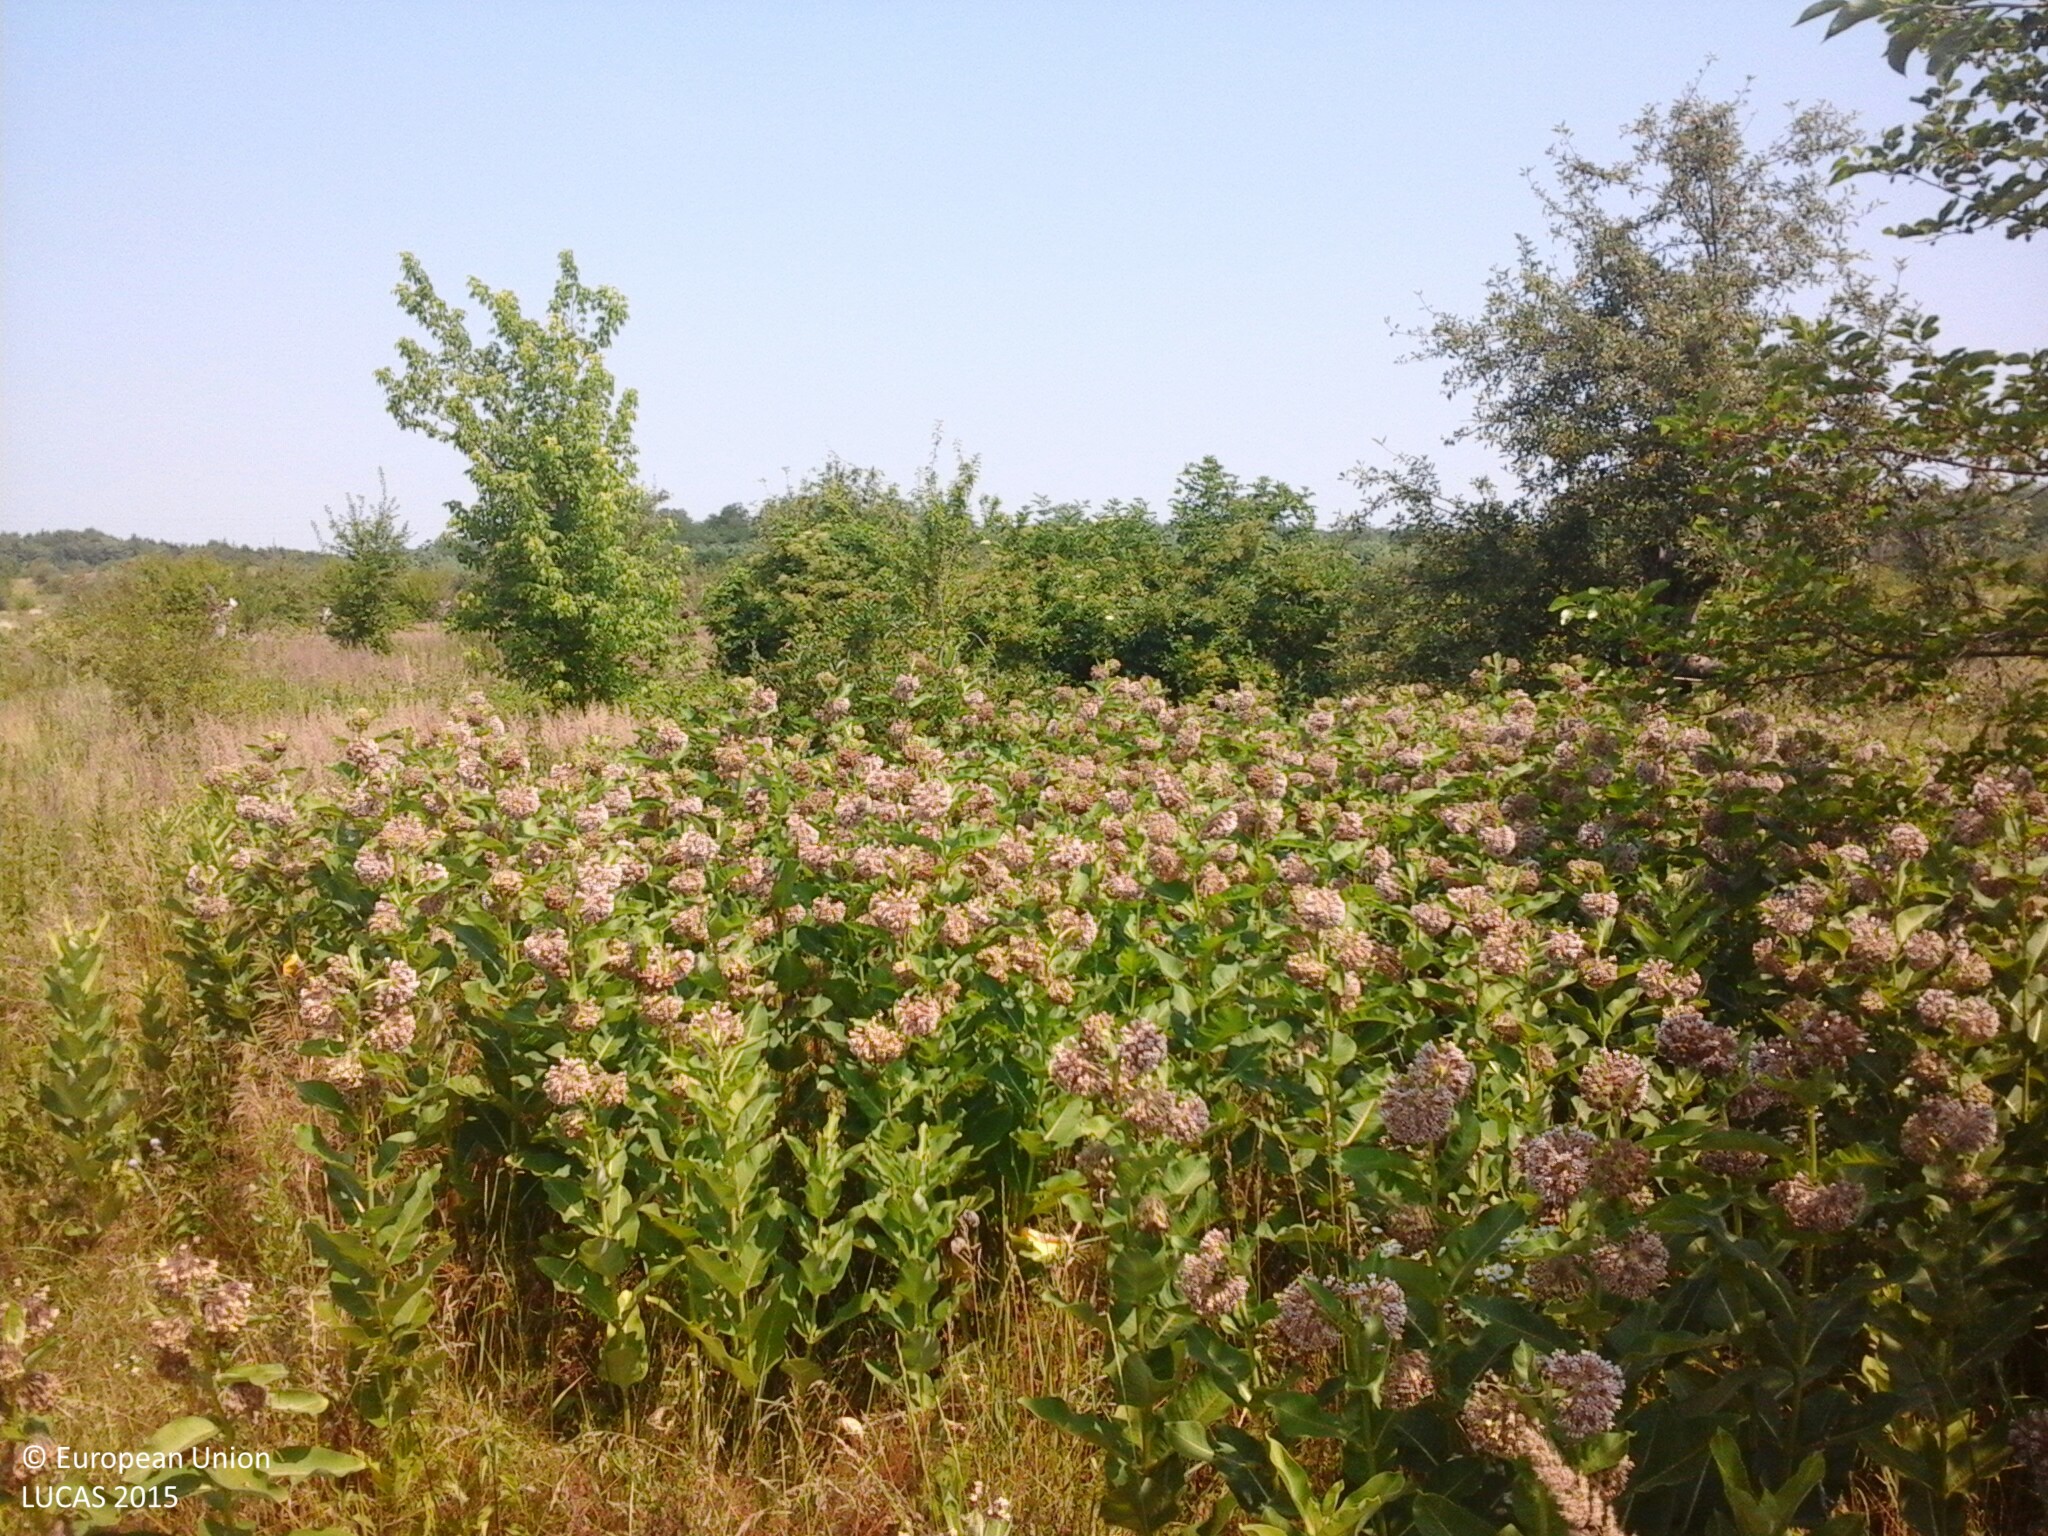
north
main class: Grassland
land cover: Grassland with sparse tree/shrub cover
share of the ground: > 75 %
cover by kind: herbaceous plants 90 %, broadleaved forest trees 5 %, shrubs 5 %
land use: Abandoned areas
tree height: < 5 m
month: July
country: HU
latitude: 48.1207
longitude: 22.2407
